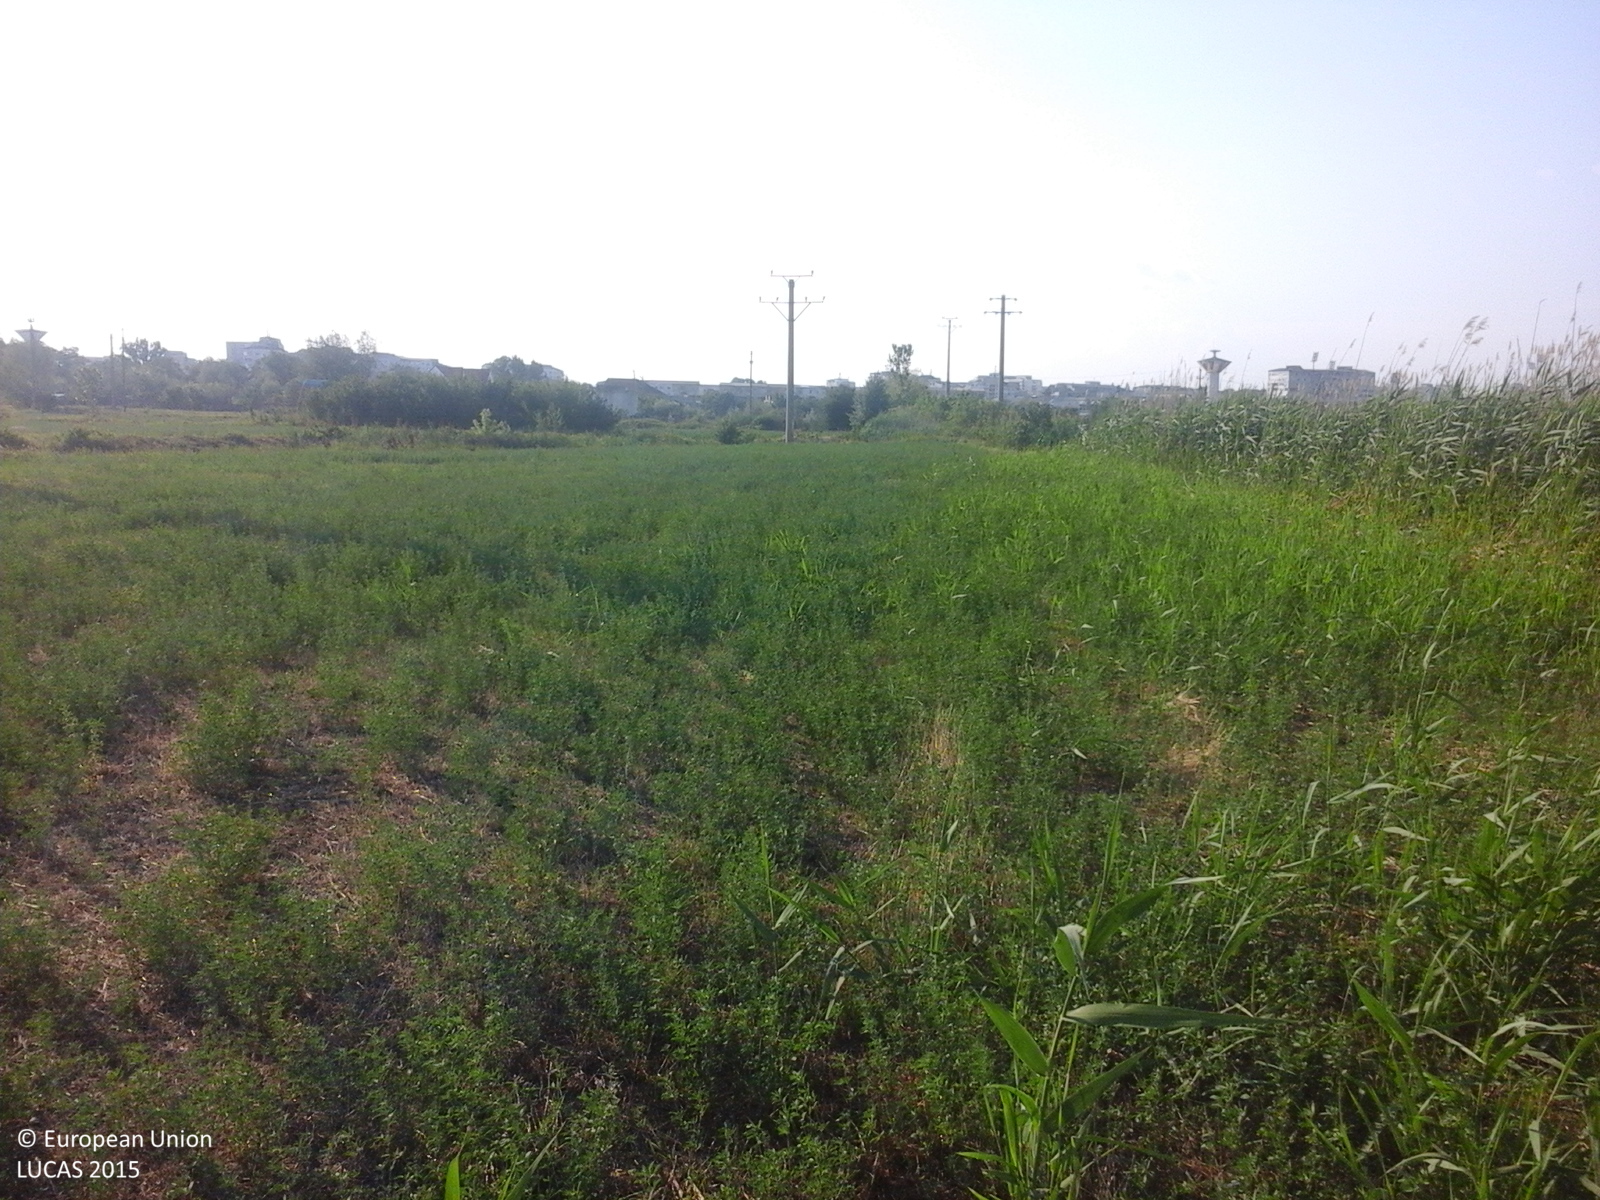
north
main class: Cropland
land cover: Lucerne
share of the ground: > 75 %
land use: Agriculture (excluding fallow land and kitchen gardens)
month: June
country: RO
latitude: 46.6223
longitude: 27.7363
